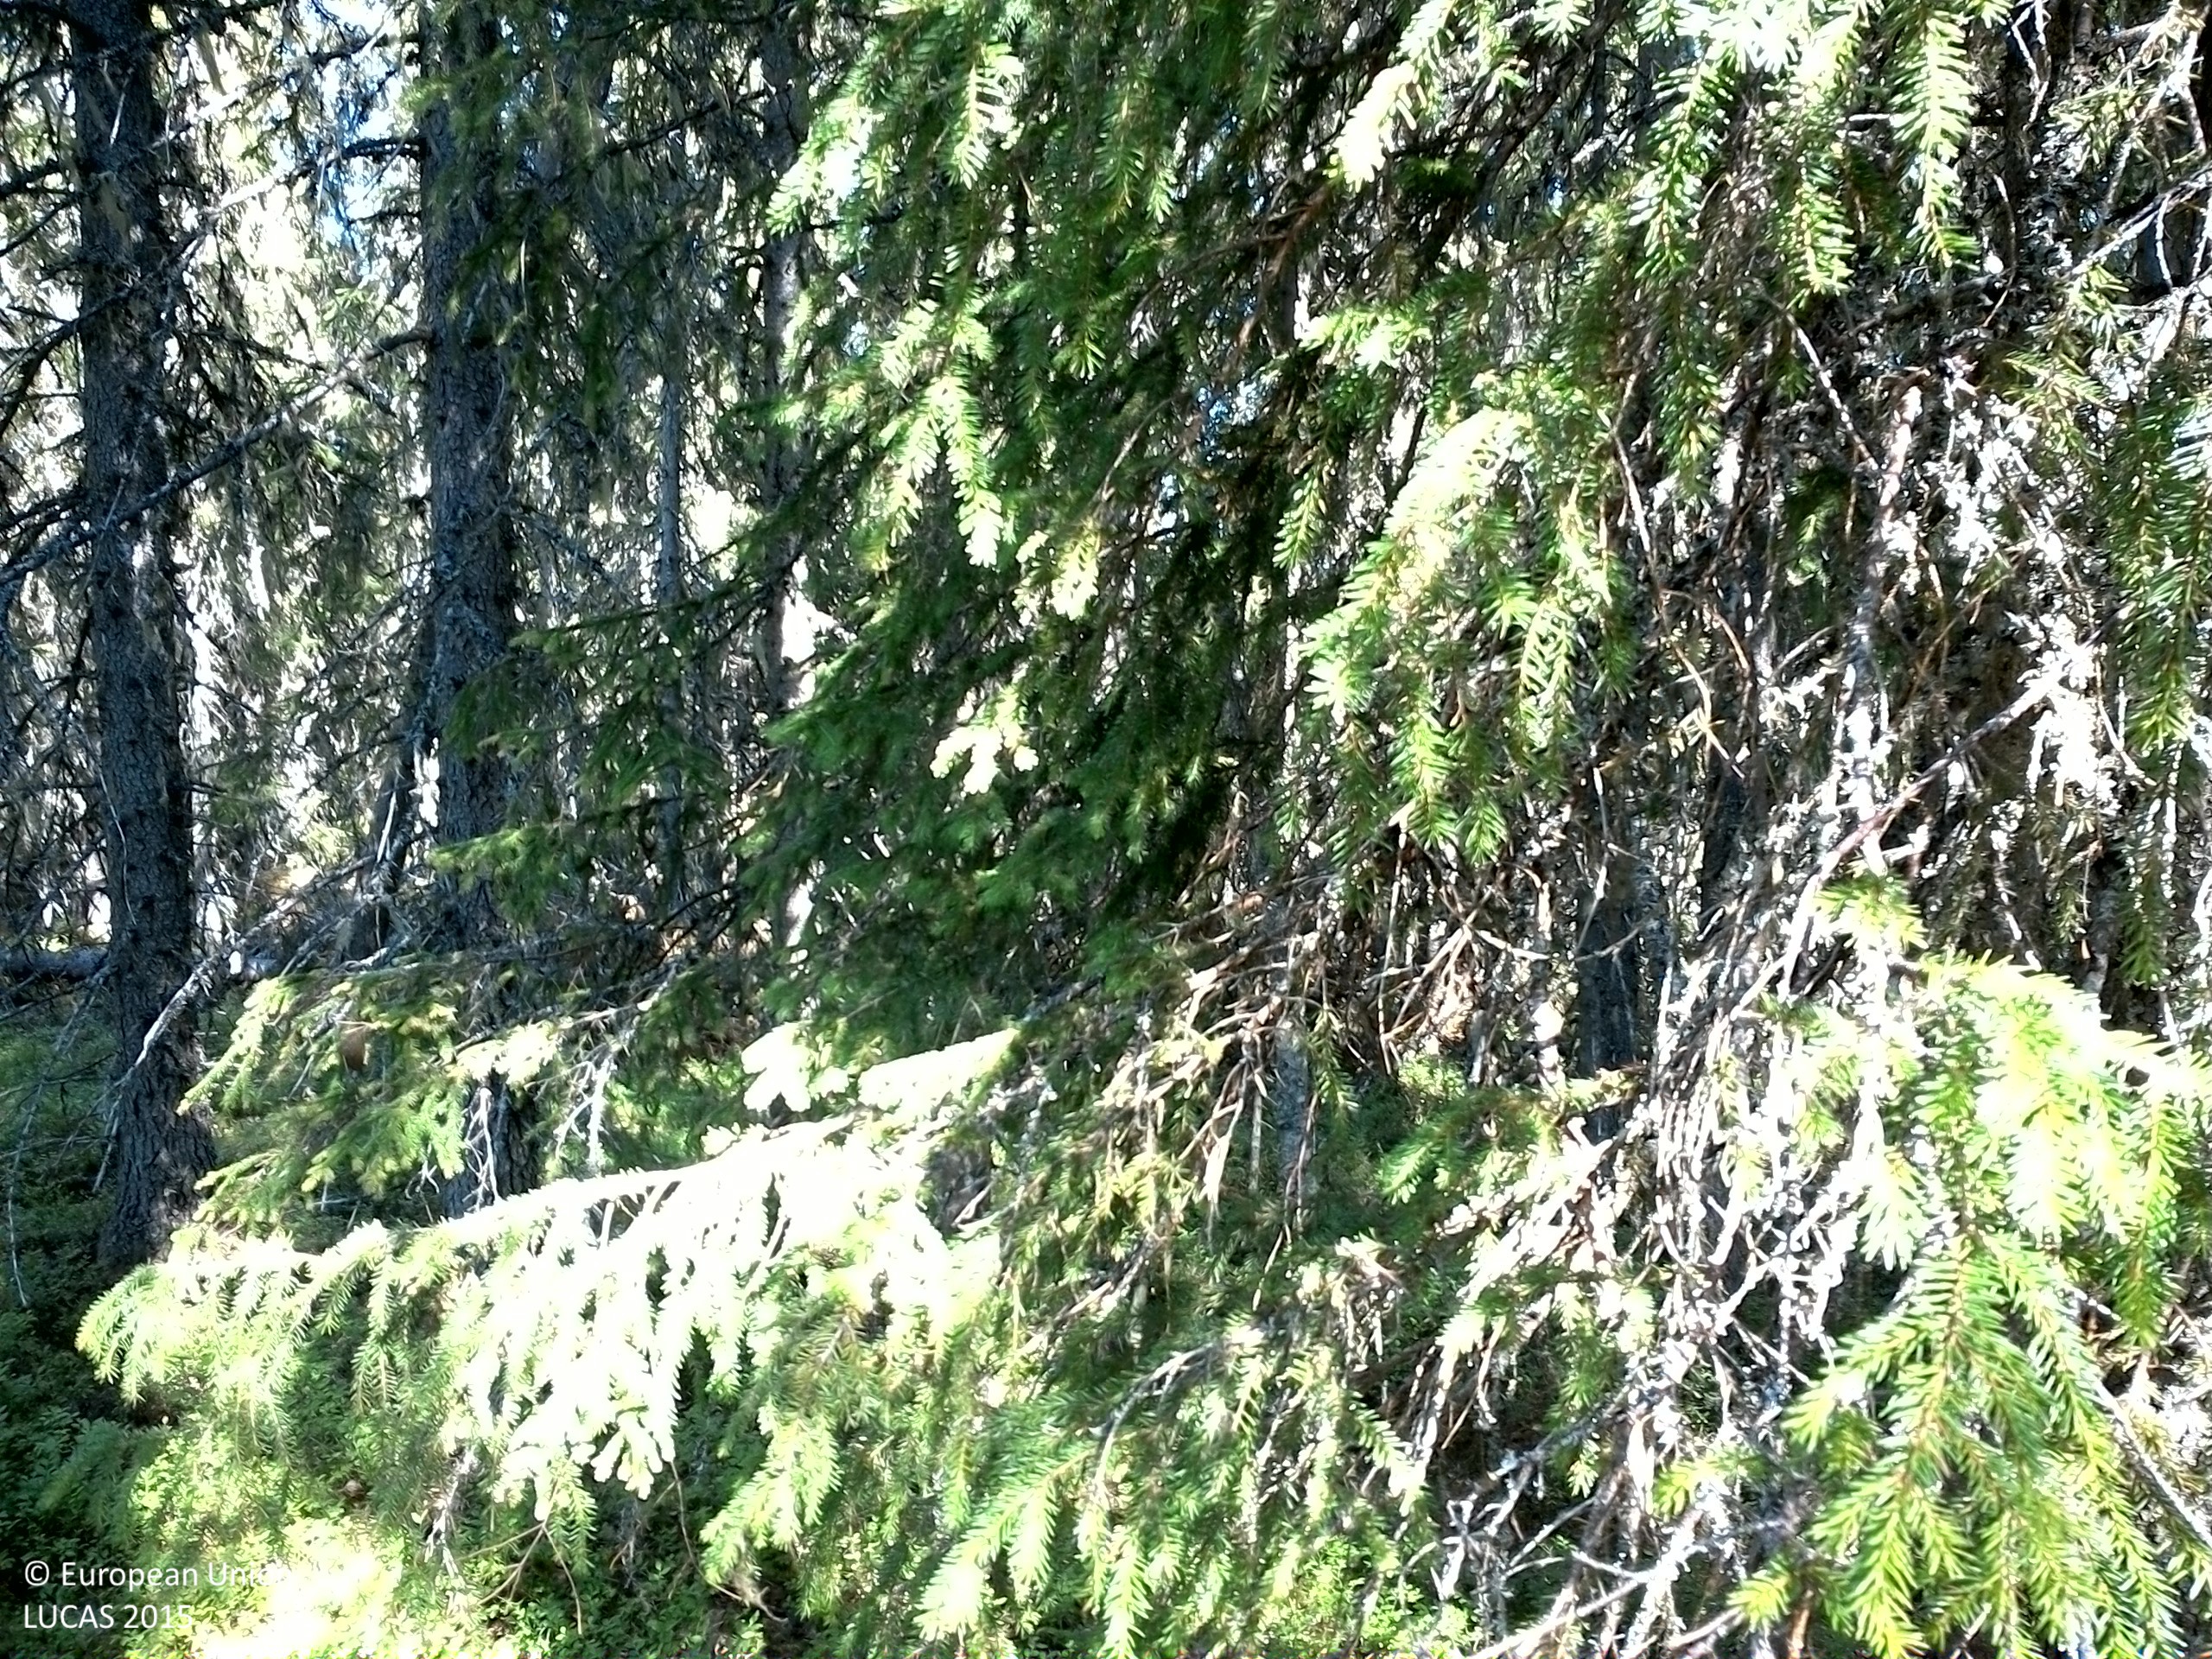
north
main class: Woodland
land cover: Spruce dominated coniferous woodland
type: boreal forest
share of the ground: 50 - 75 %
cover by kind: coniferous forest trees 55 %, shrubs 25 %, broadleaved forest trees 10 %, lichens and mosses 10 %
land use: Amenities, museums, leisure
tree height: > 5 m
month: August
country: SE
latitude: 63.9960
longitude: 16.8599
